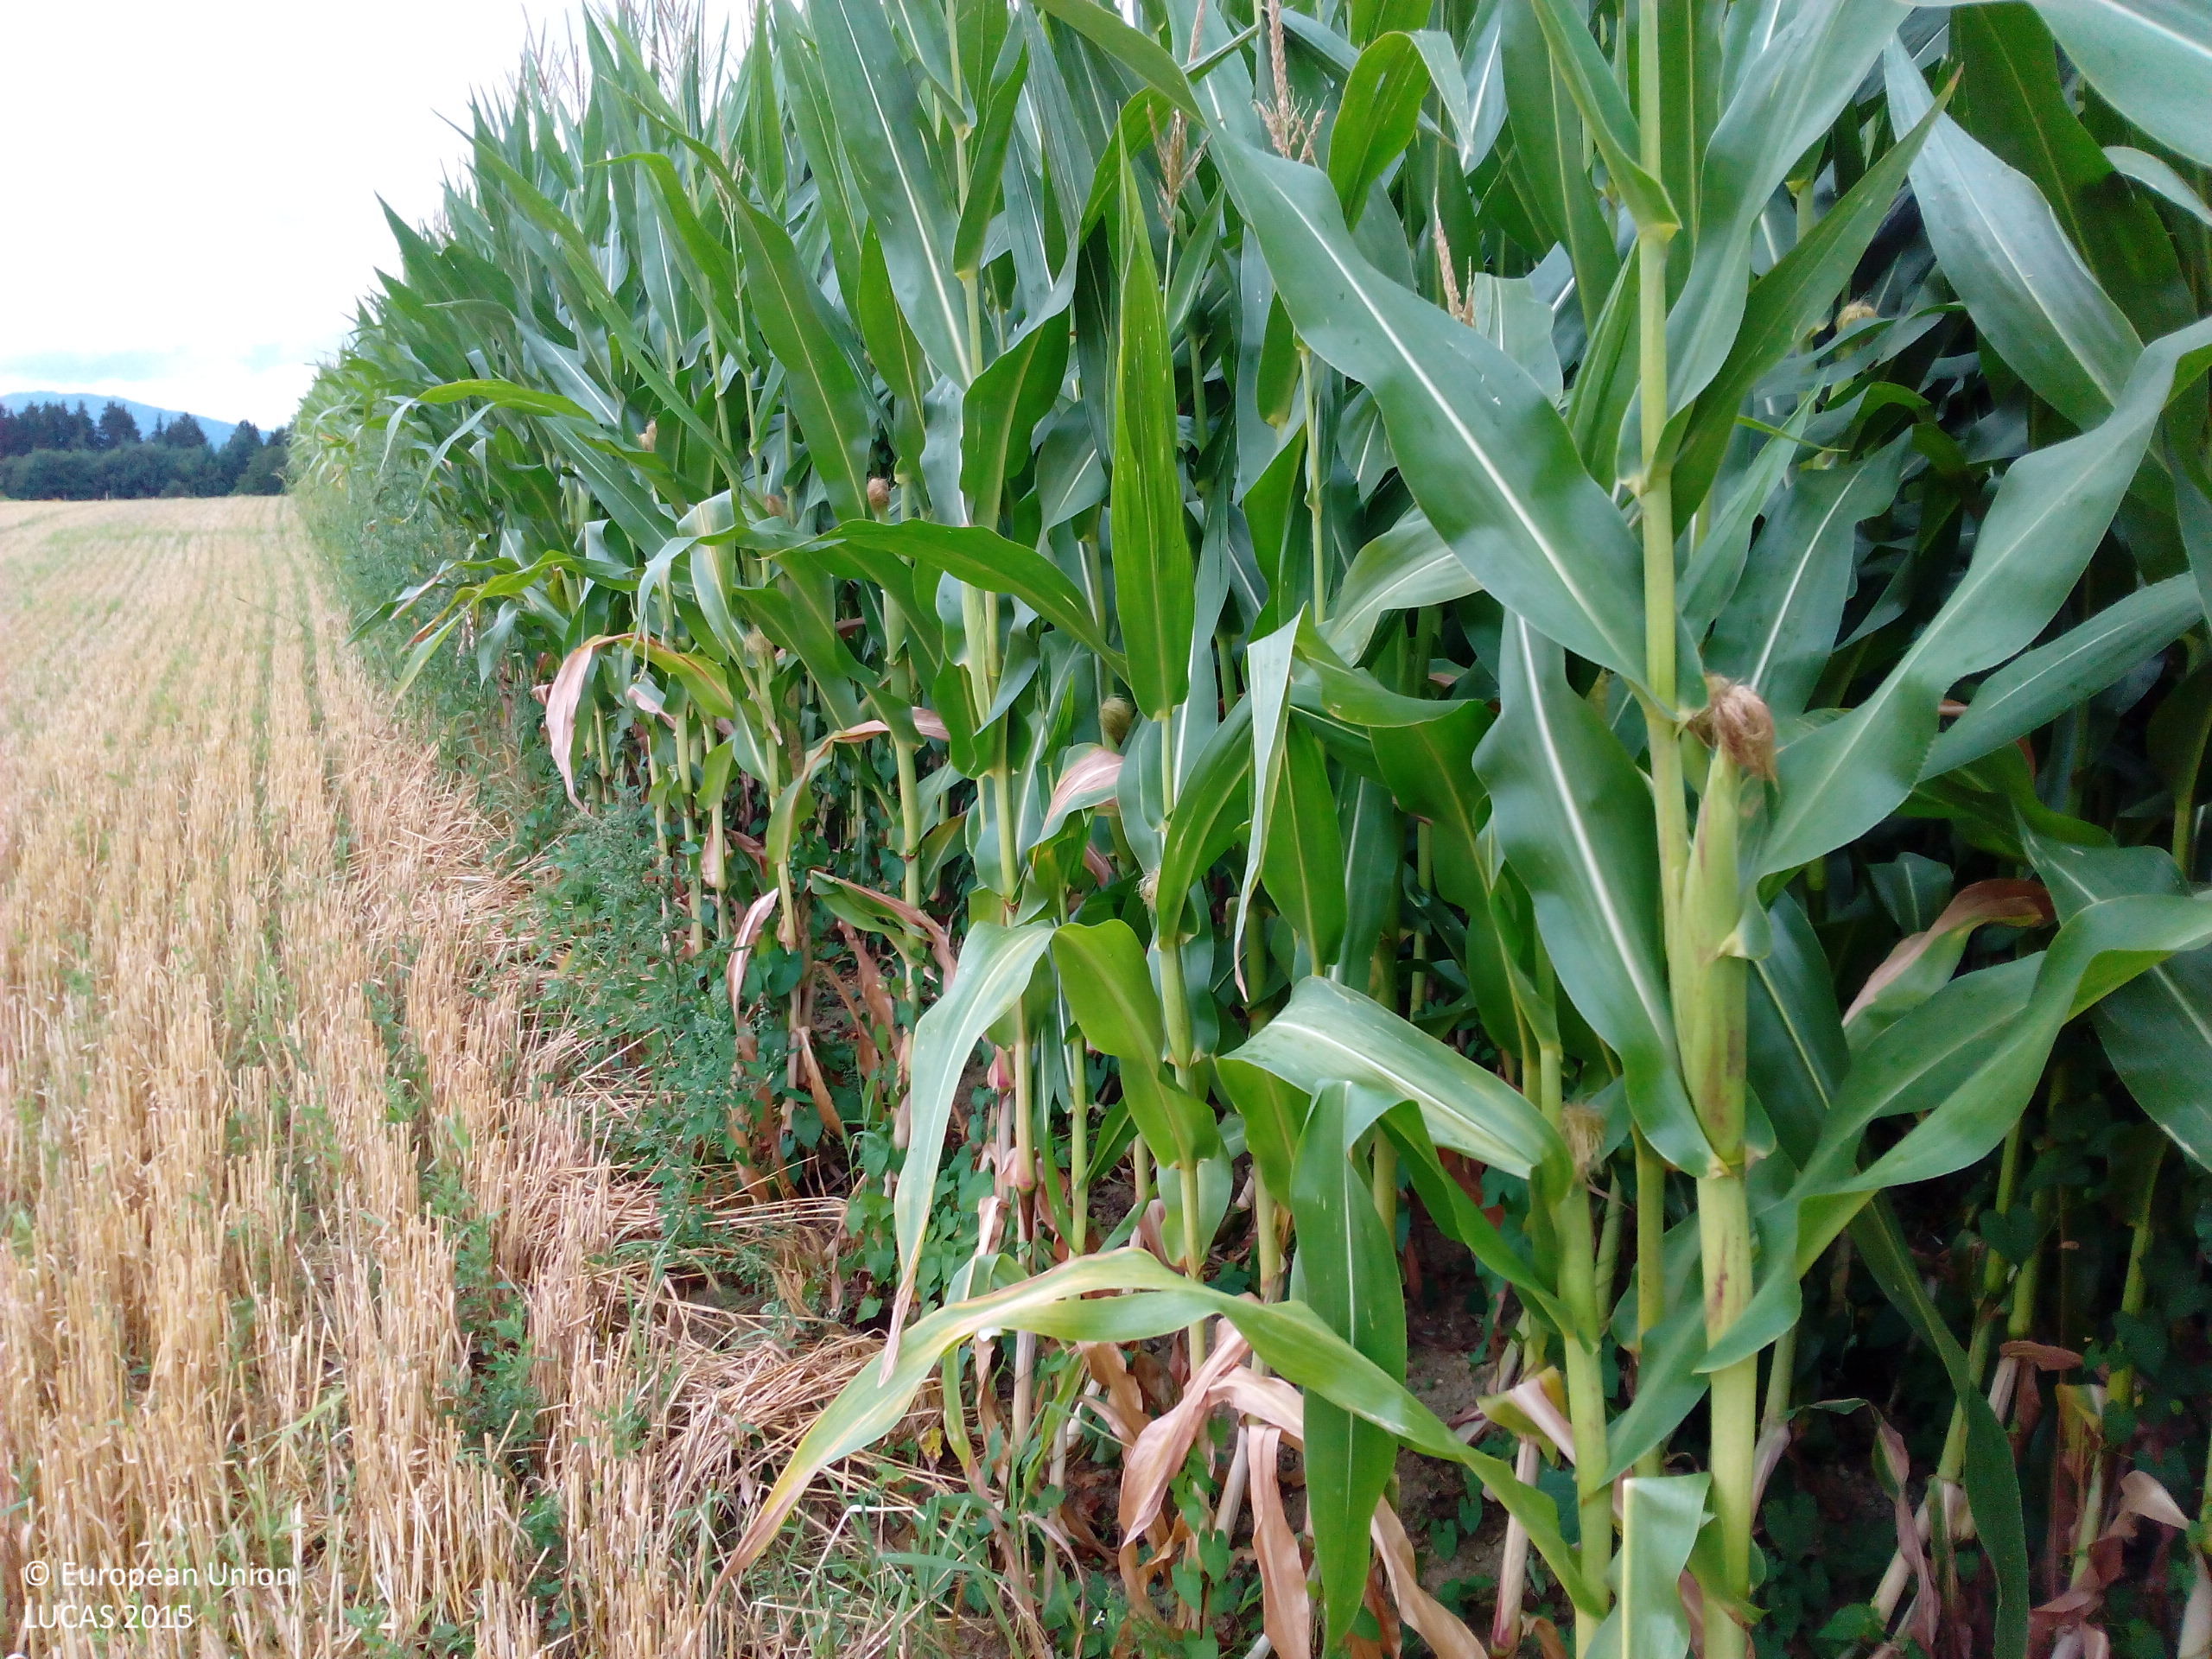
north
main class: Cropland
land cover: Maize
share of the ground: > 75 %
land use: Agriculture (excluding fallow land and kitchen gardens)
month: July
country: DE
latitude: 48.8688
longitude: 12.9306
